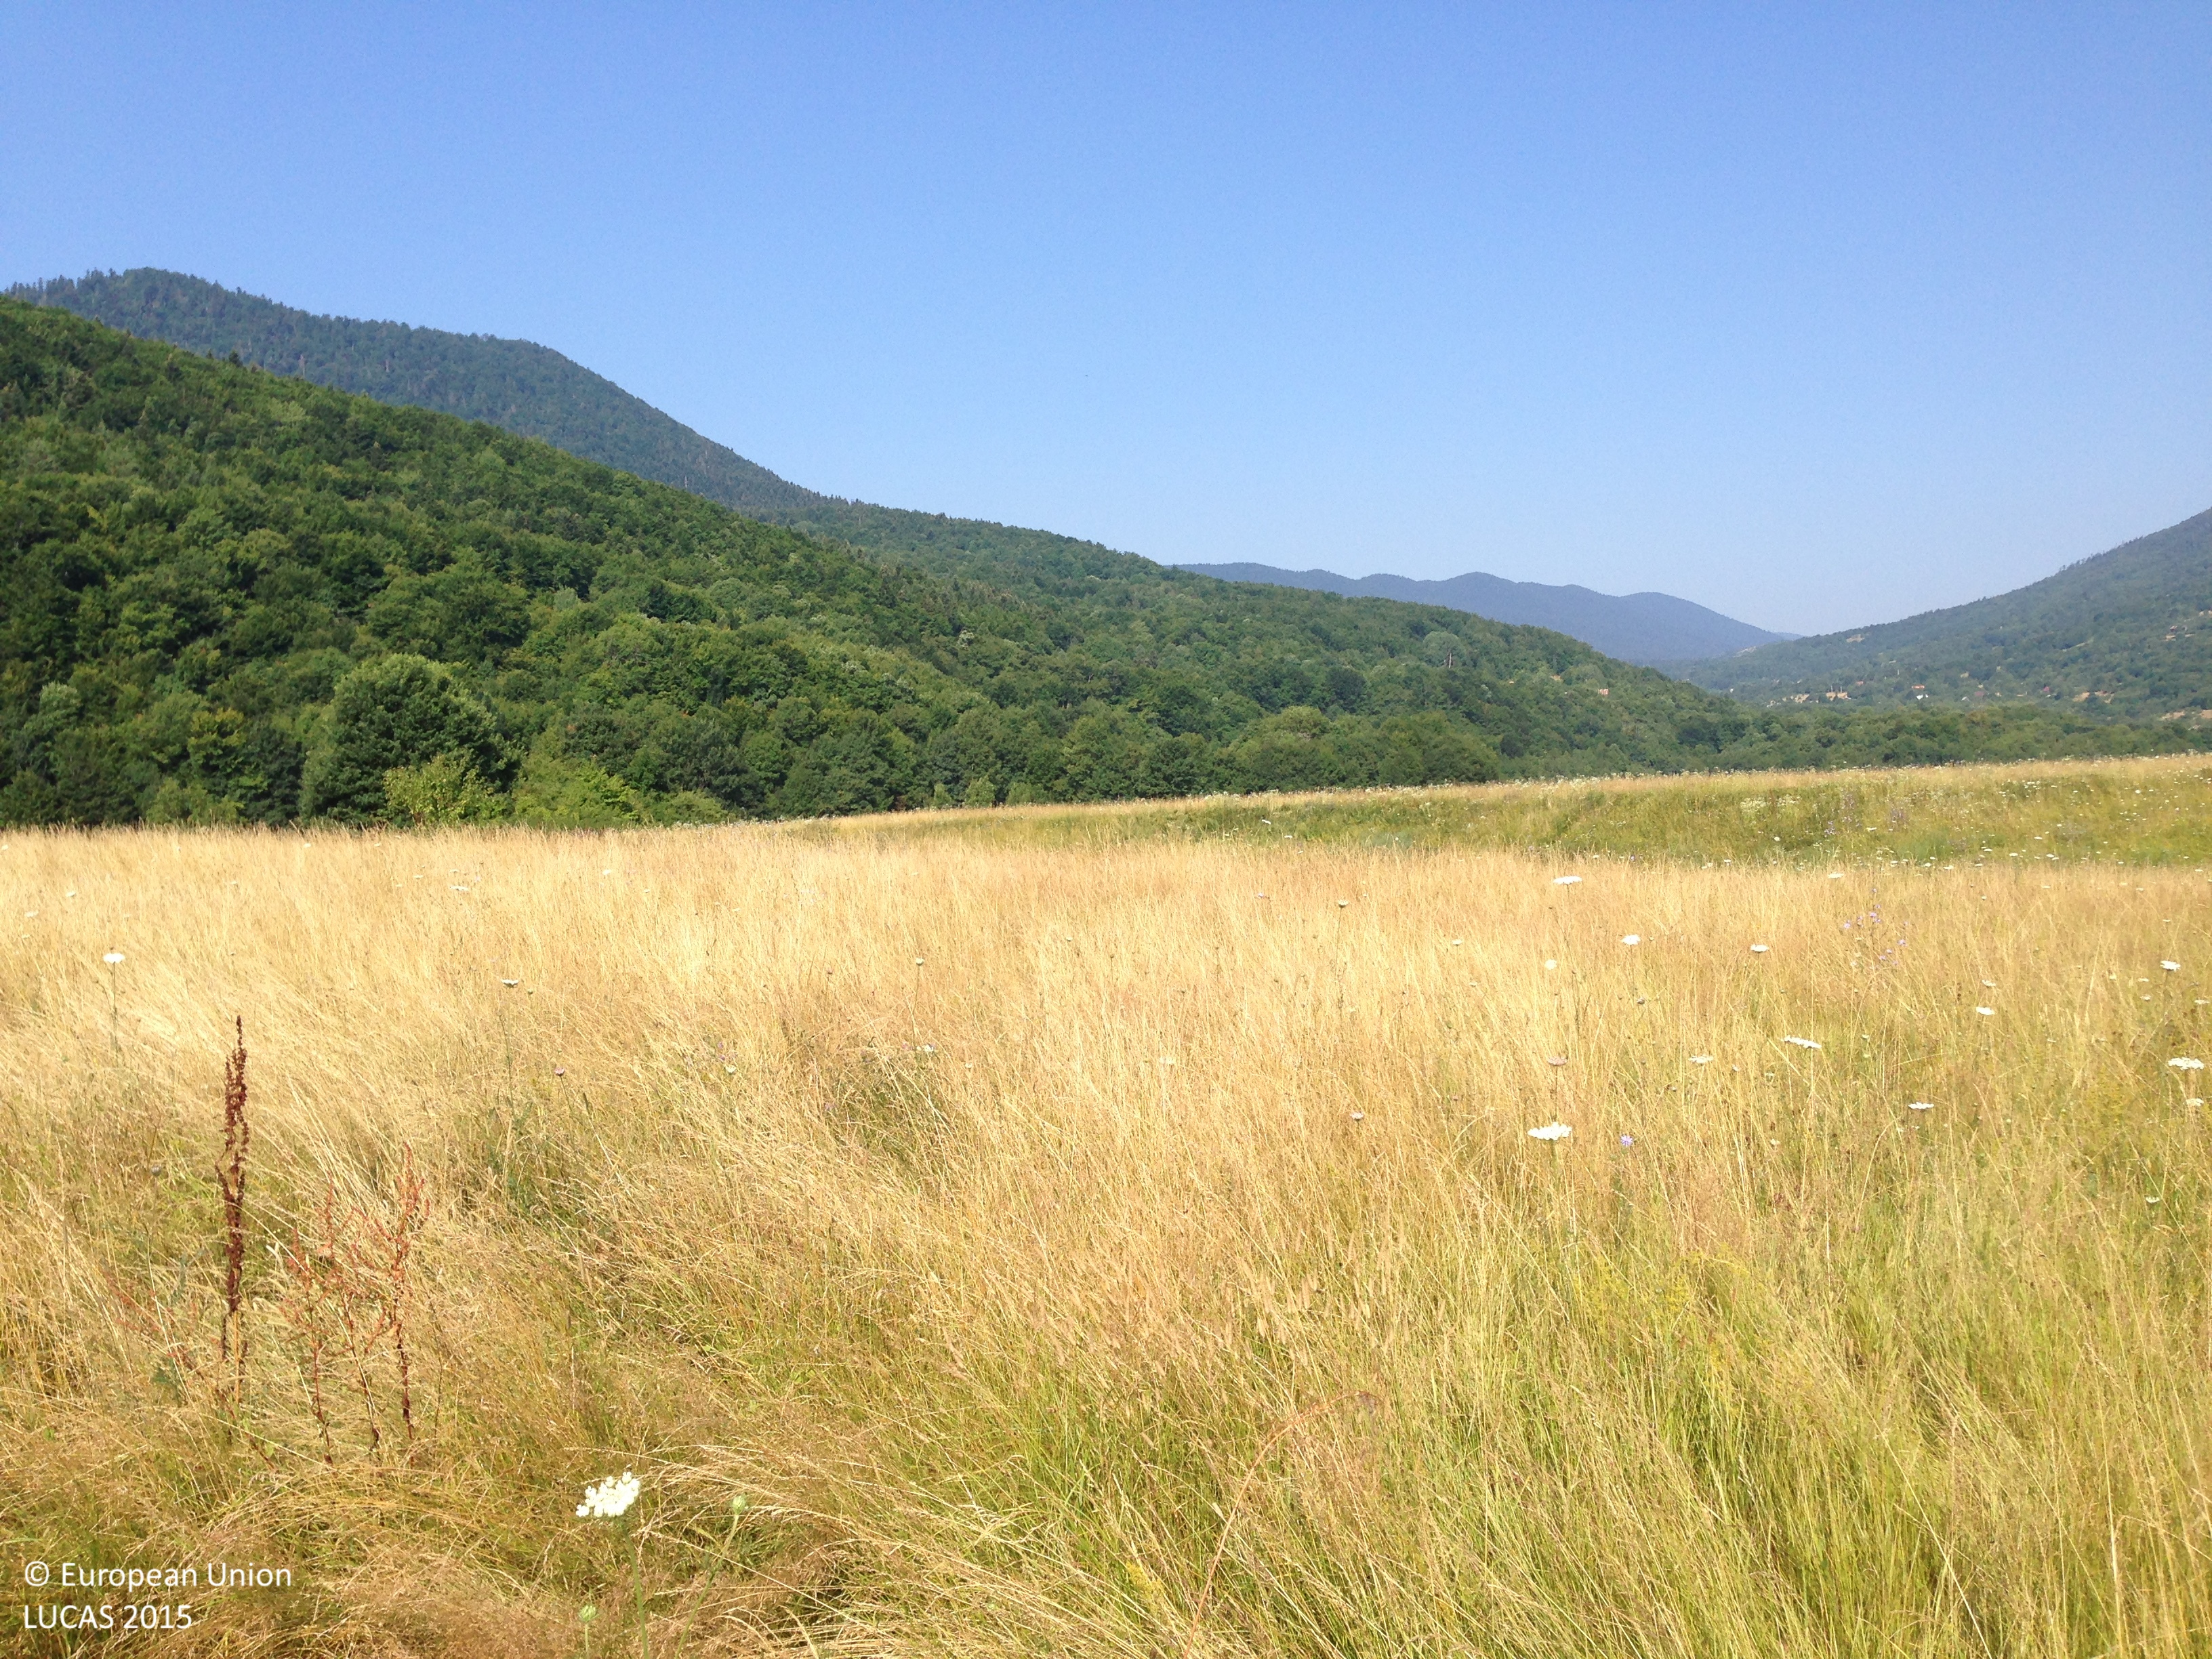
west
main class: Grassland
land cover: Grassland without tree/shrub cover
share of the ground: > 75 %
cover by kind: herbaceous plants 95 %, shrubs 5 %
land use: Agriculture (excluding fallow land and kitchen gardens)
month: July
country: HR
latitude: 44.7629
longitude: 15.1864
